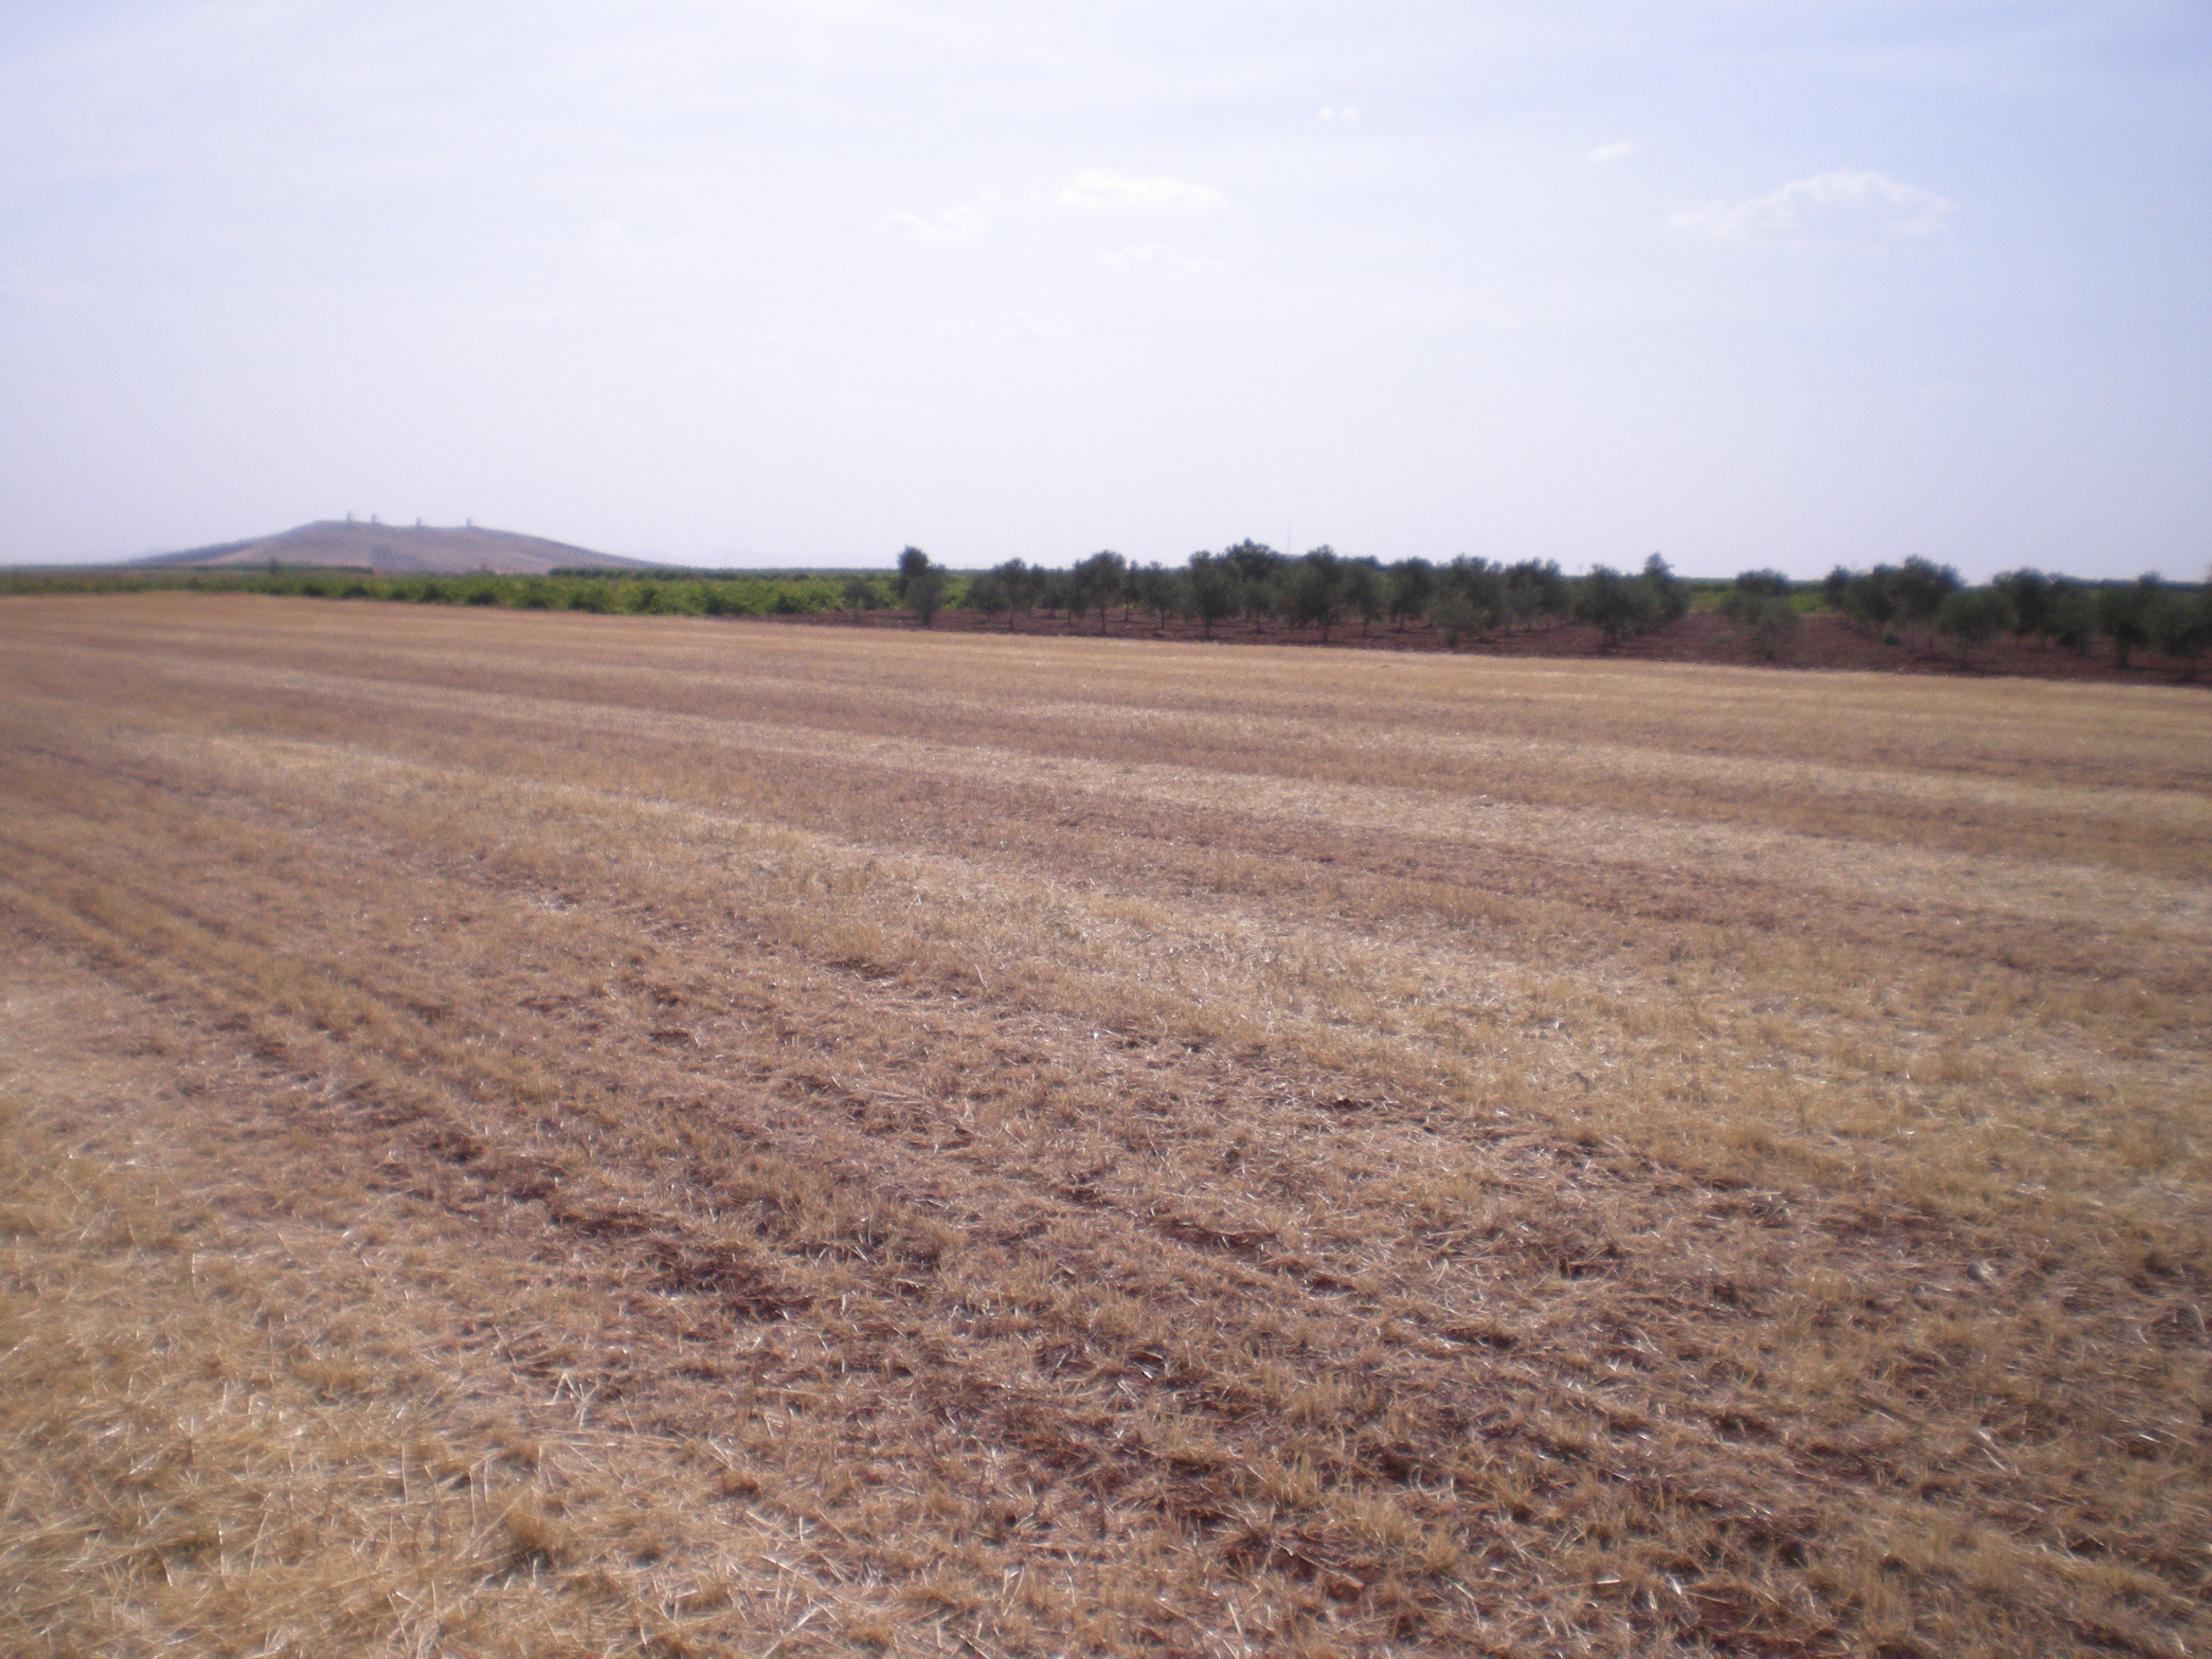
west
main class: Cropland
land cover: Barley
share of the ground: < 10 %
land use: Agriculture (excluding fallow land and kitchen gardens)
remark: Harvested field
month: July
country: ES
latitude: 39.3785
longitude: -3.1465
